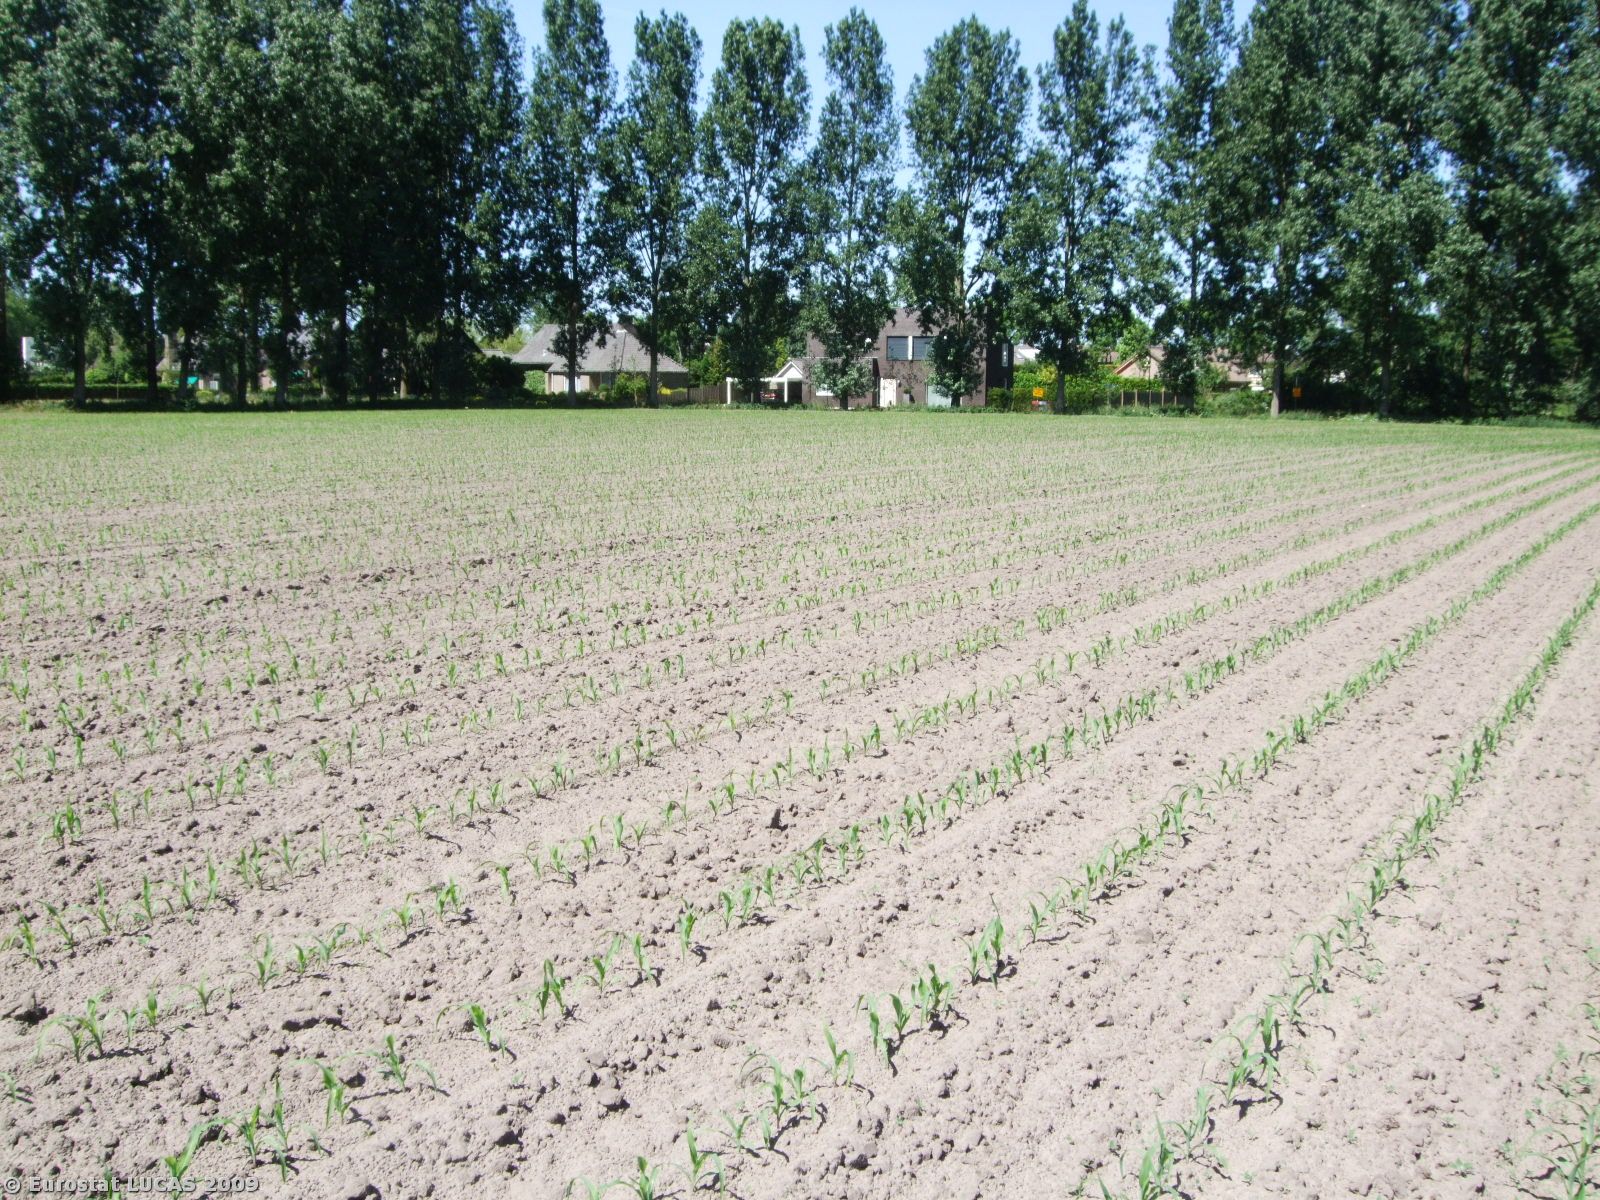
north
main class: Cropland
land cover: Maize
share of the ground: 25 - 50 %
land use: Agriculture (excluding fallow land and kitchen gardens)
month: June
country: NL
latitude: 51.5669
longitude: 5.3670
